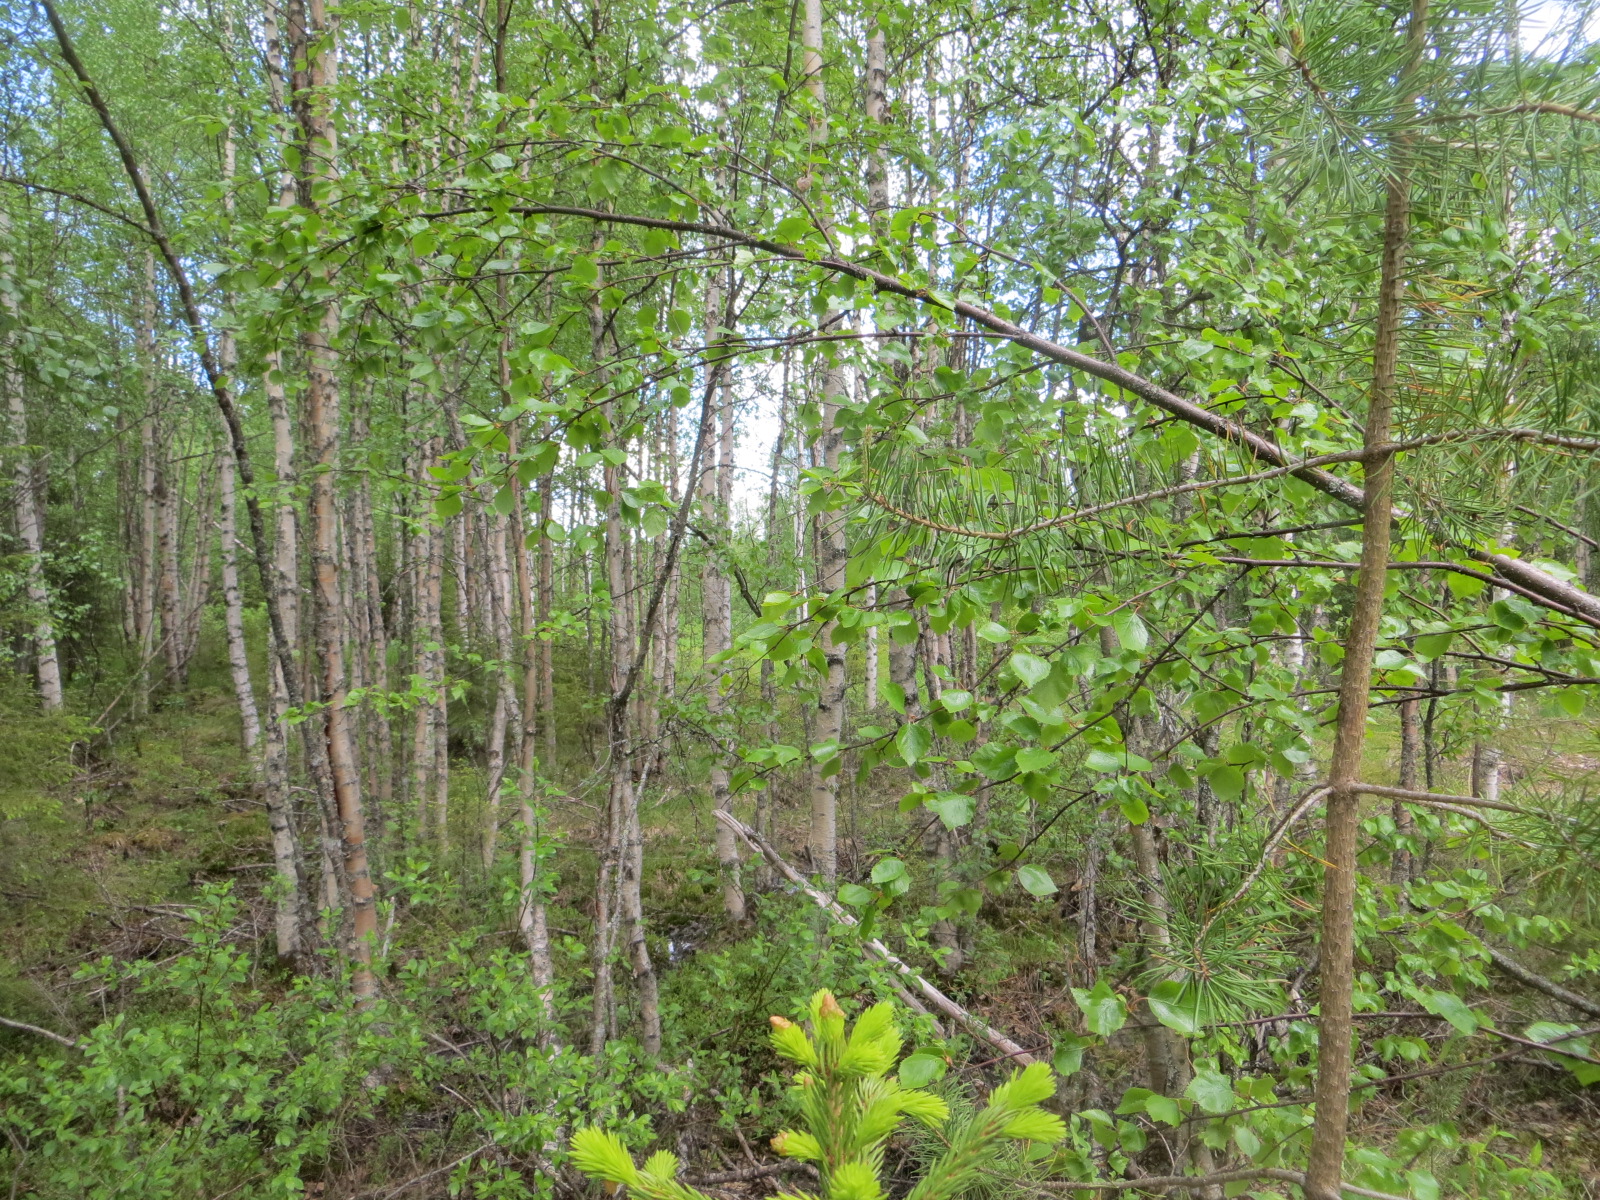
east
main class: Woodland
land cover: Other mixed woodland
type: boreal forest
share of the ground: > 75 %
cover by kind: broadleaved forest trees 45 %, coniferous forest trees 30 %, shrubs 20 %, lichens and mosses 5 %
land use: Forestry
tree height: > 5 m
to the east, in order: Other mixed woodland; Ditches and canals; Other mixed woodland; Ditches and canals; Pine dominated mixed woodland; Tracks; Pine dominated mixed woodland; Broadleaved woodland; Grass margins; Electric lines; Grass margins; Broadleaved woodland; Electric lines; Ditches and canals; Other mixed woodland
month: June
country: FI
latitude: 66.6321
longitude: 25.2627
